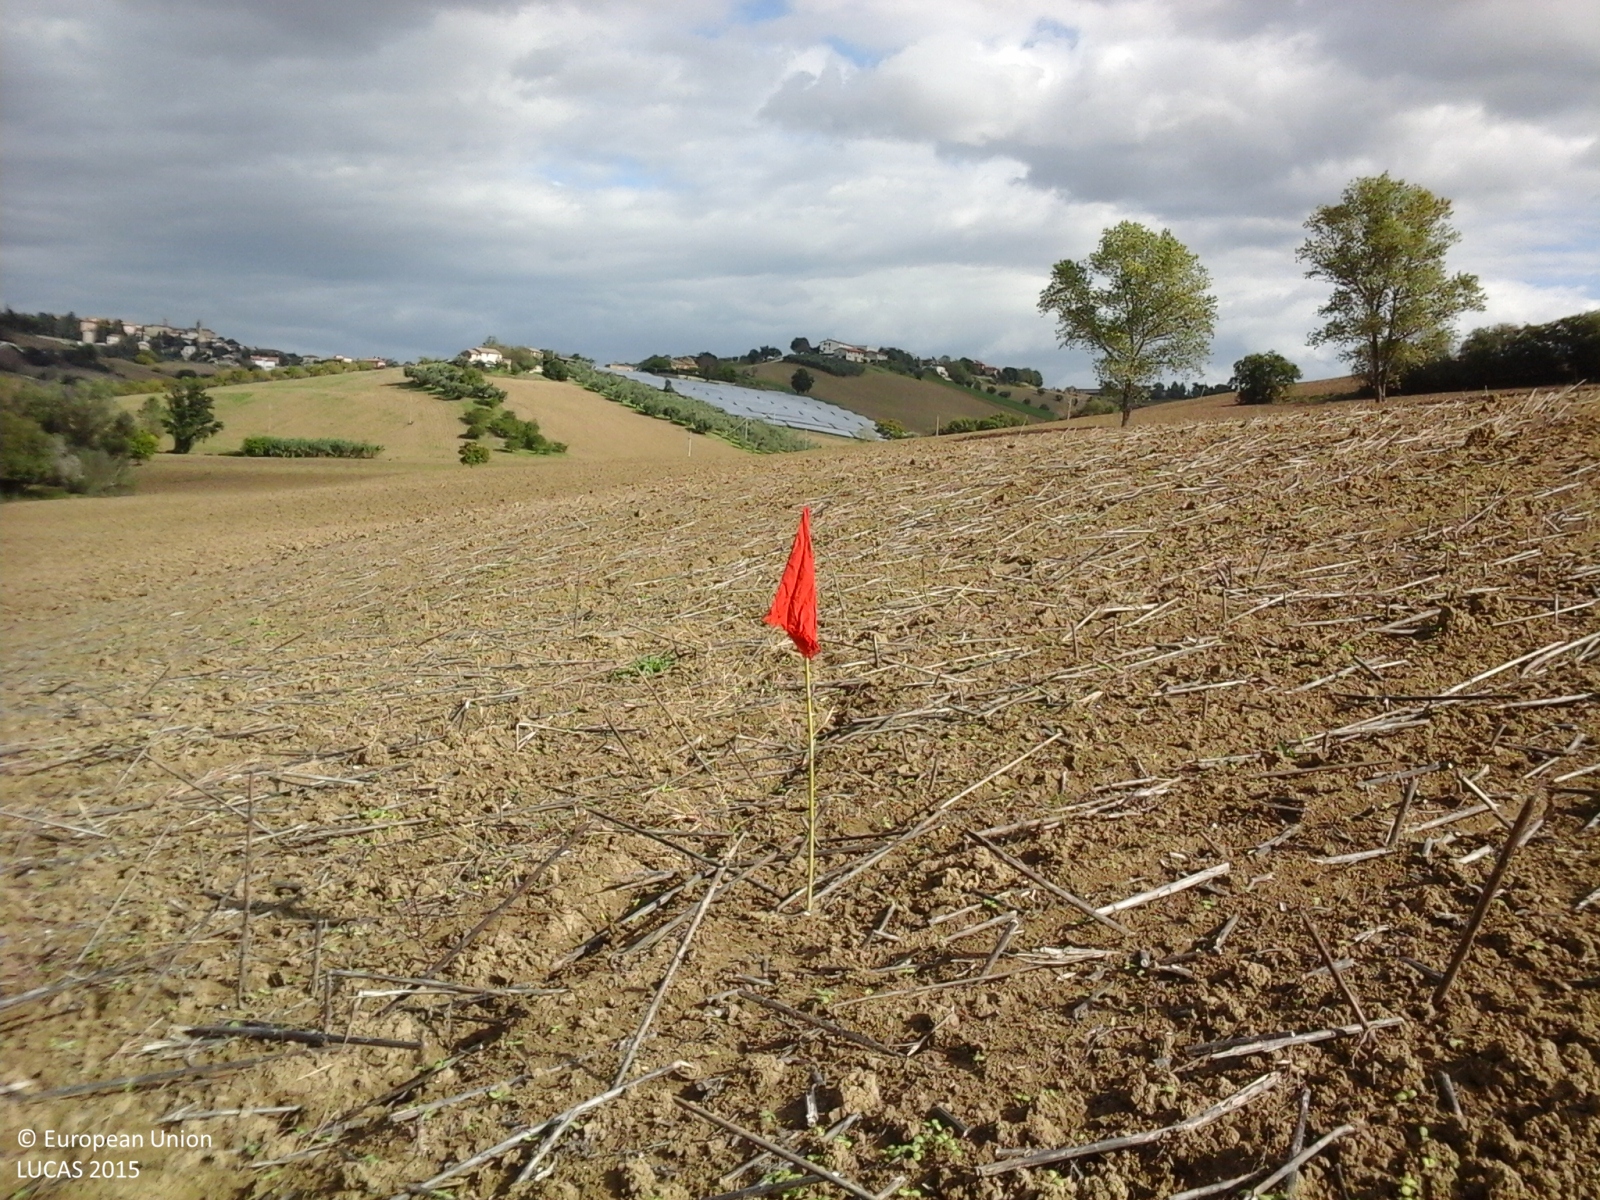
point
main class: Cropland
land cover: Sunflower
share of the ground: < 10 %
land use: Agriculture (excluding fallow land and kitchen gardens)
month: October
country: IT
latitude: 43.5611
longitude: 13.1986
